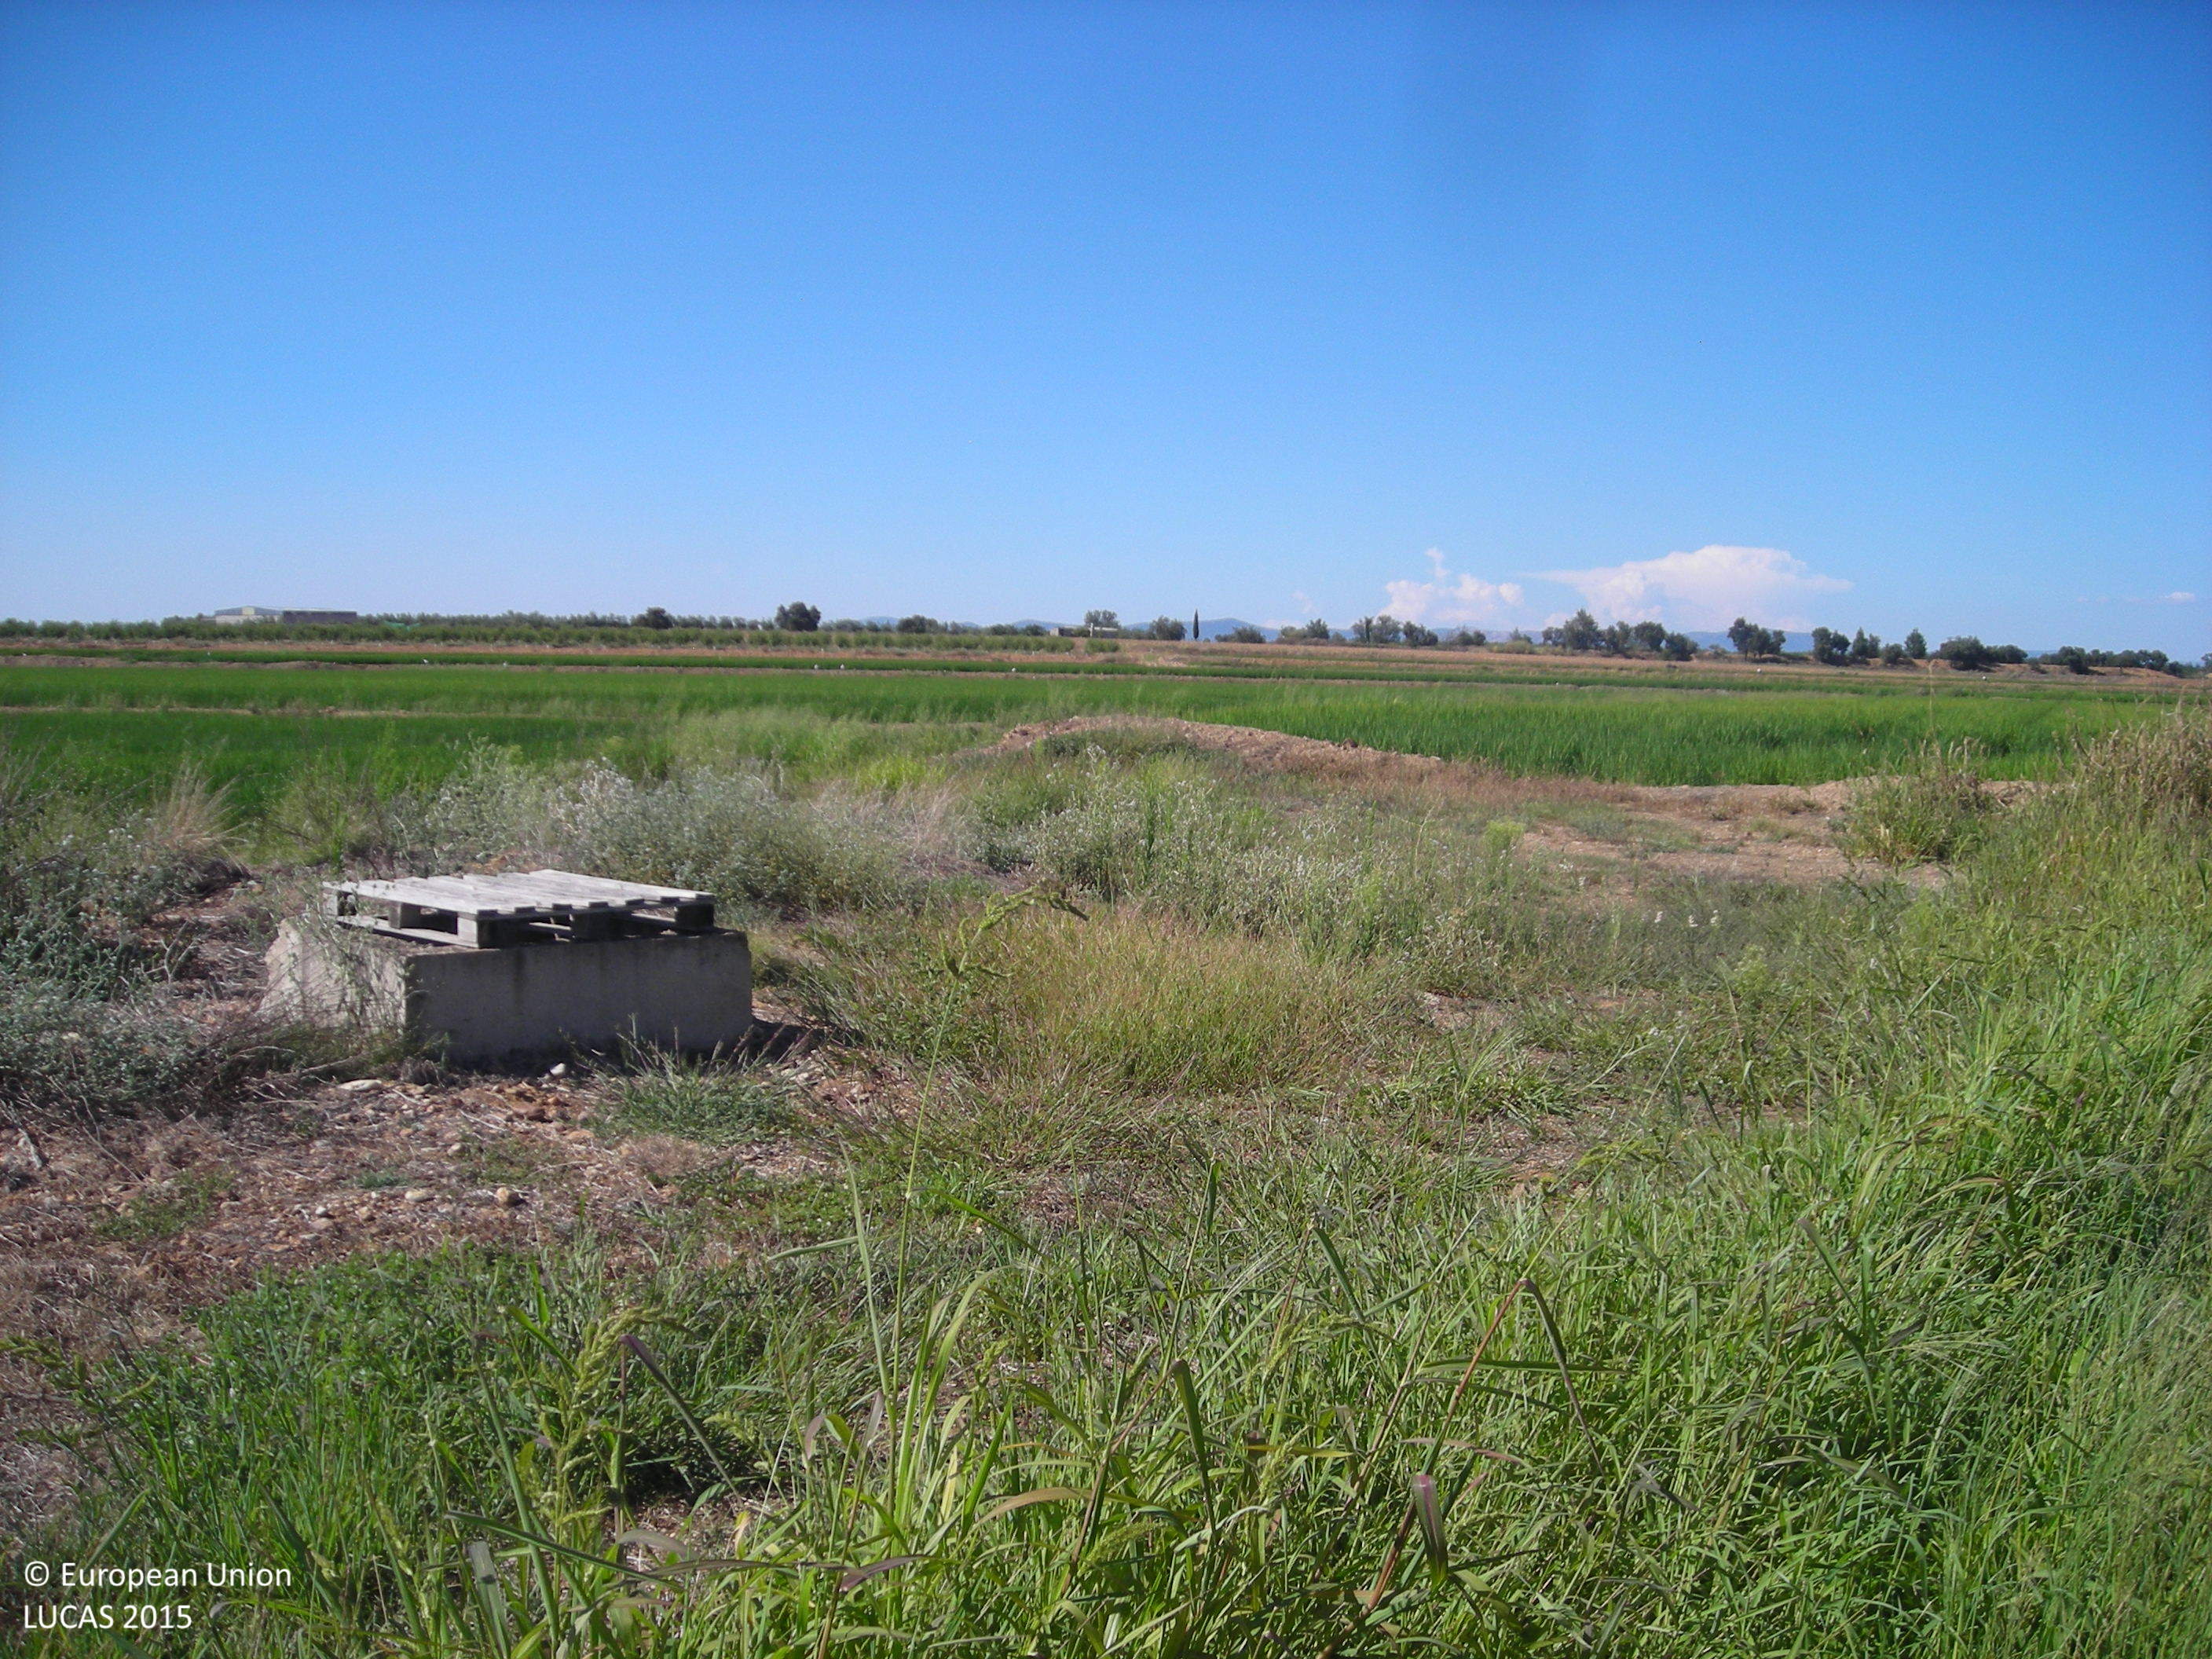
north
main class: Cropland
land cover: Rice
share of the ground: > 75 %
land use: Agriculture (excluding fallow land and kitchen gardens)
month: July
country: ES
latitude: 39.0842
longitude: -5.7132
